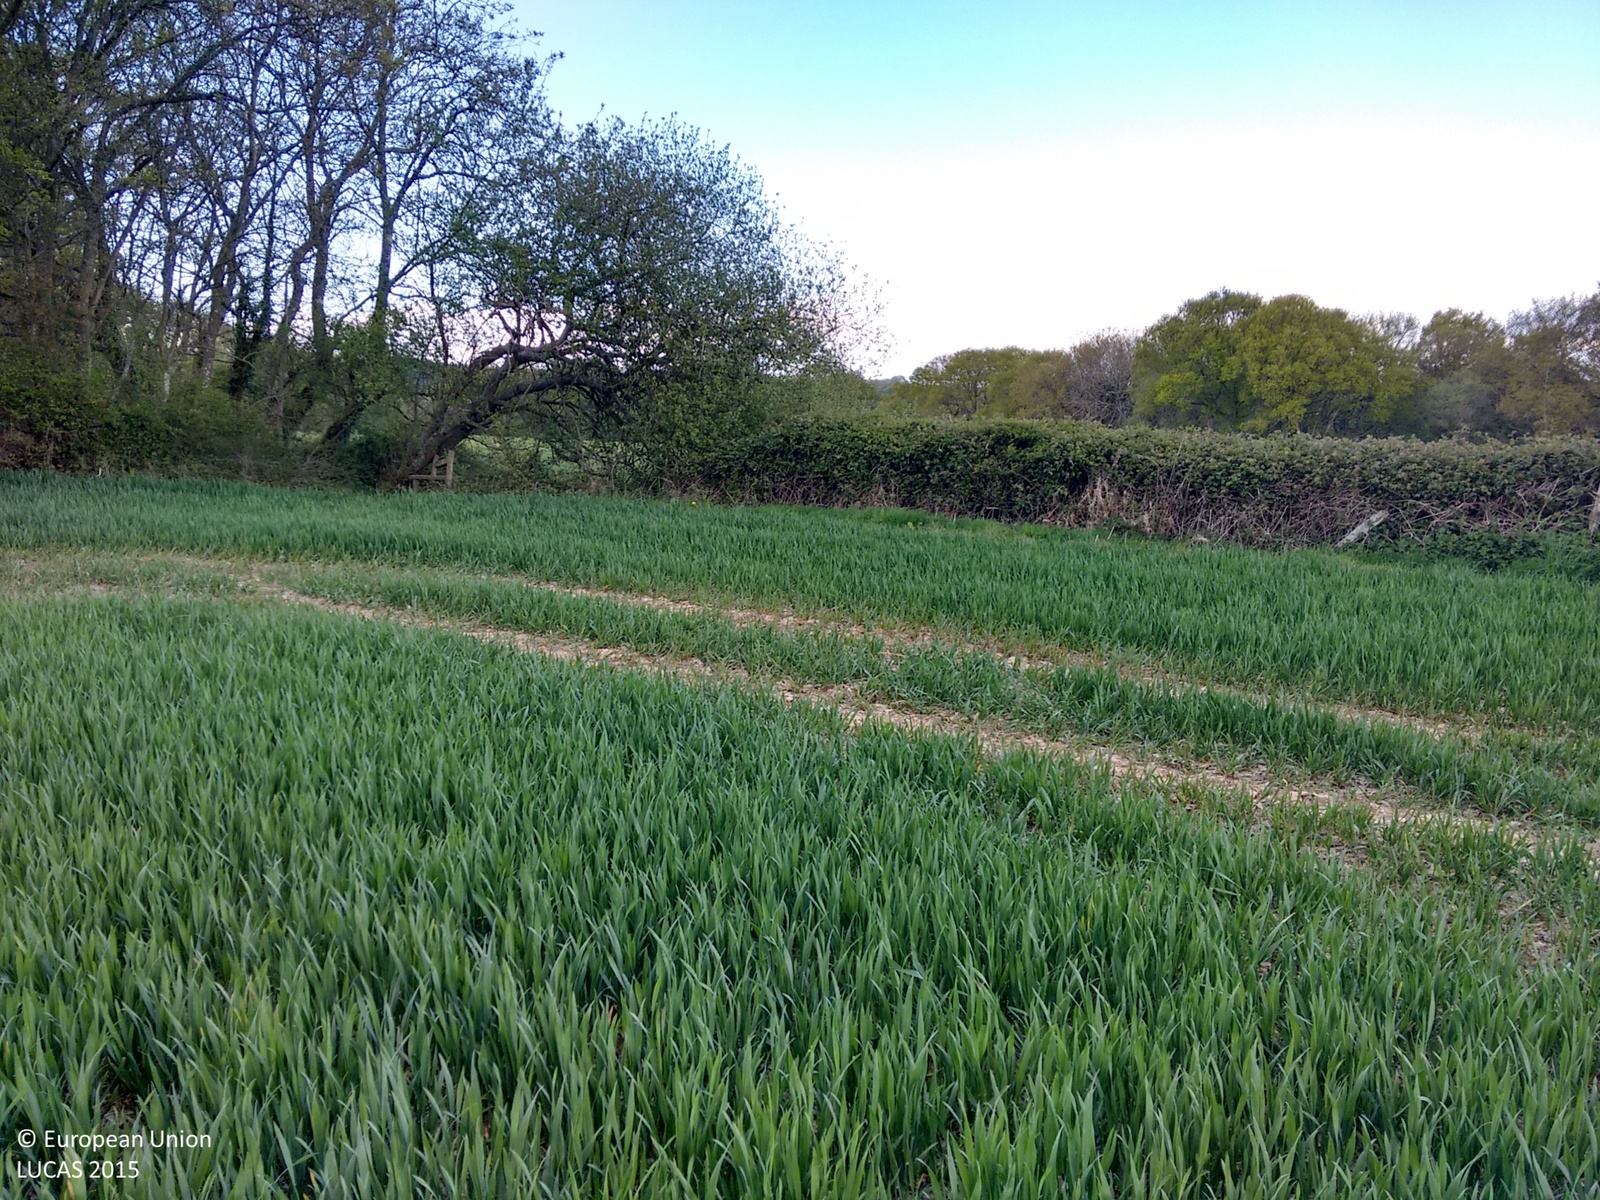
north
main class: Cropland
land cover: Common wheat
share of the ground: > 75 %
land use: Agriculture (excluding fallow land and kitchen gardens)
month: April
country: GB
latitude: 50.9241
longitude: -1.8786
